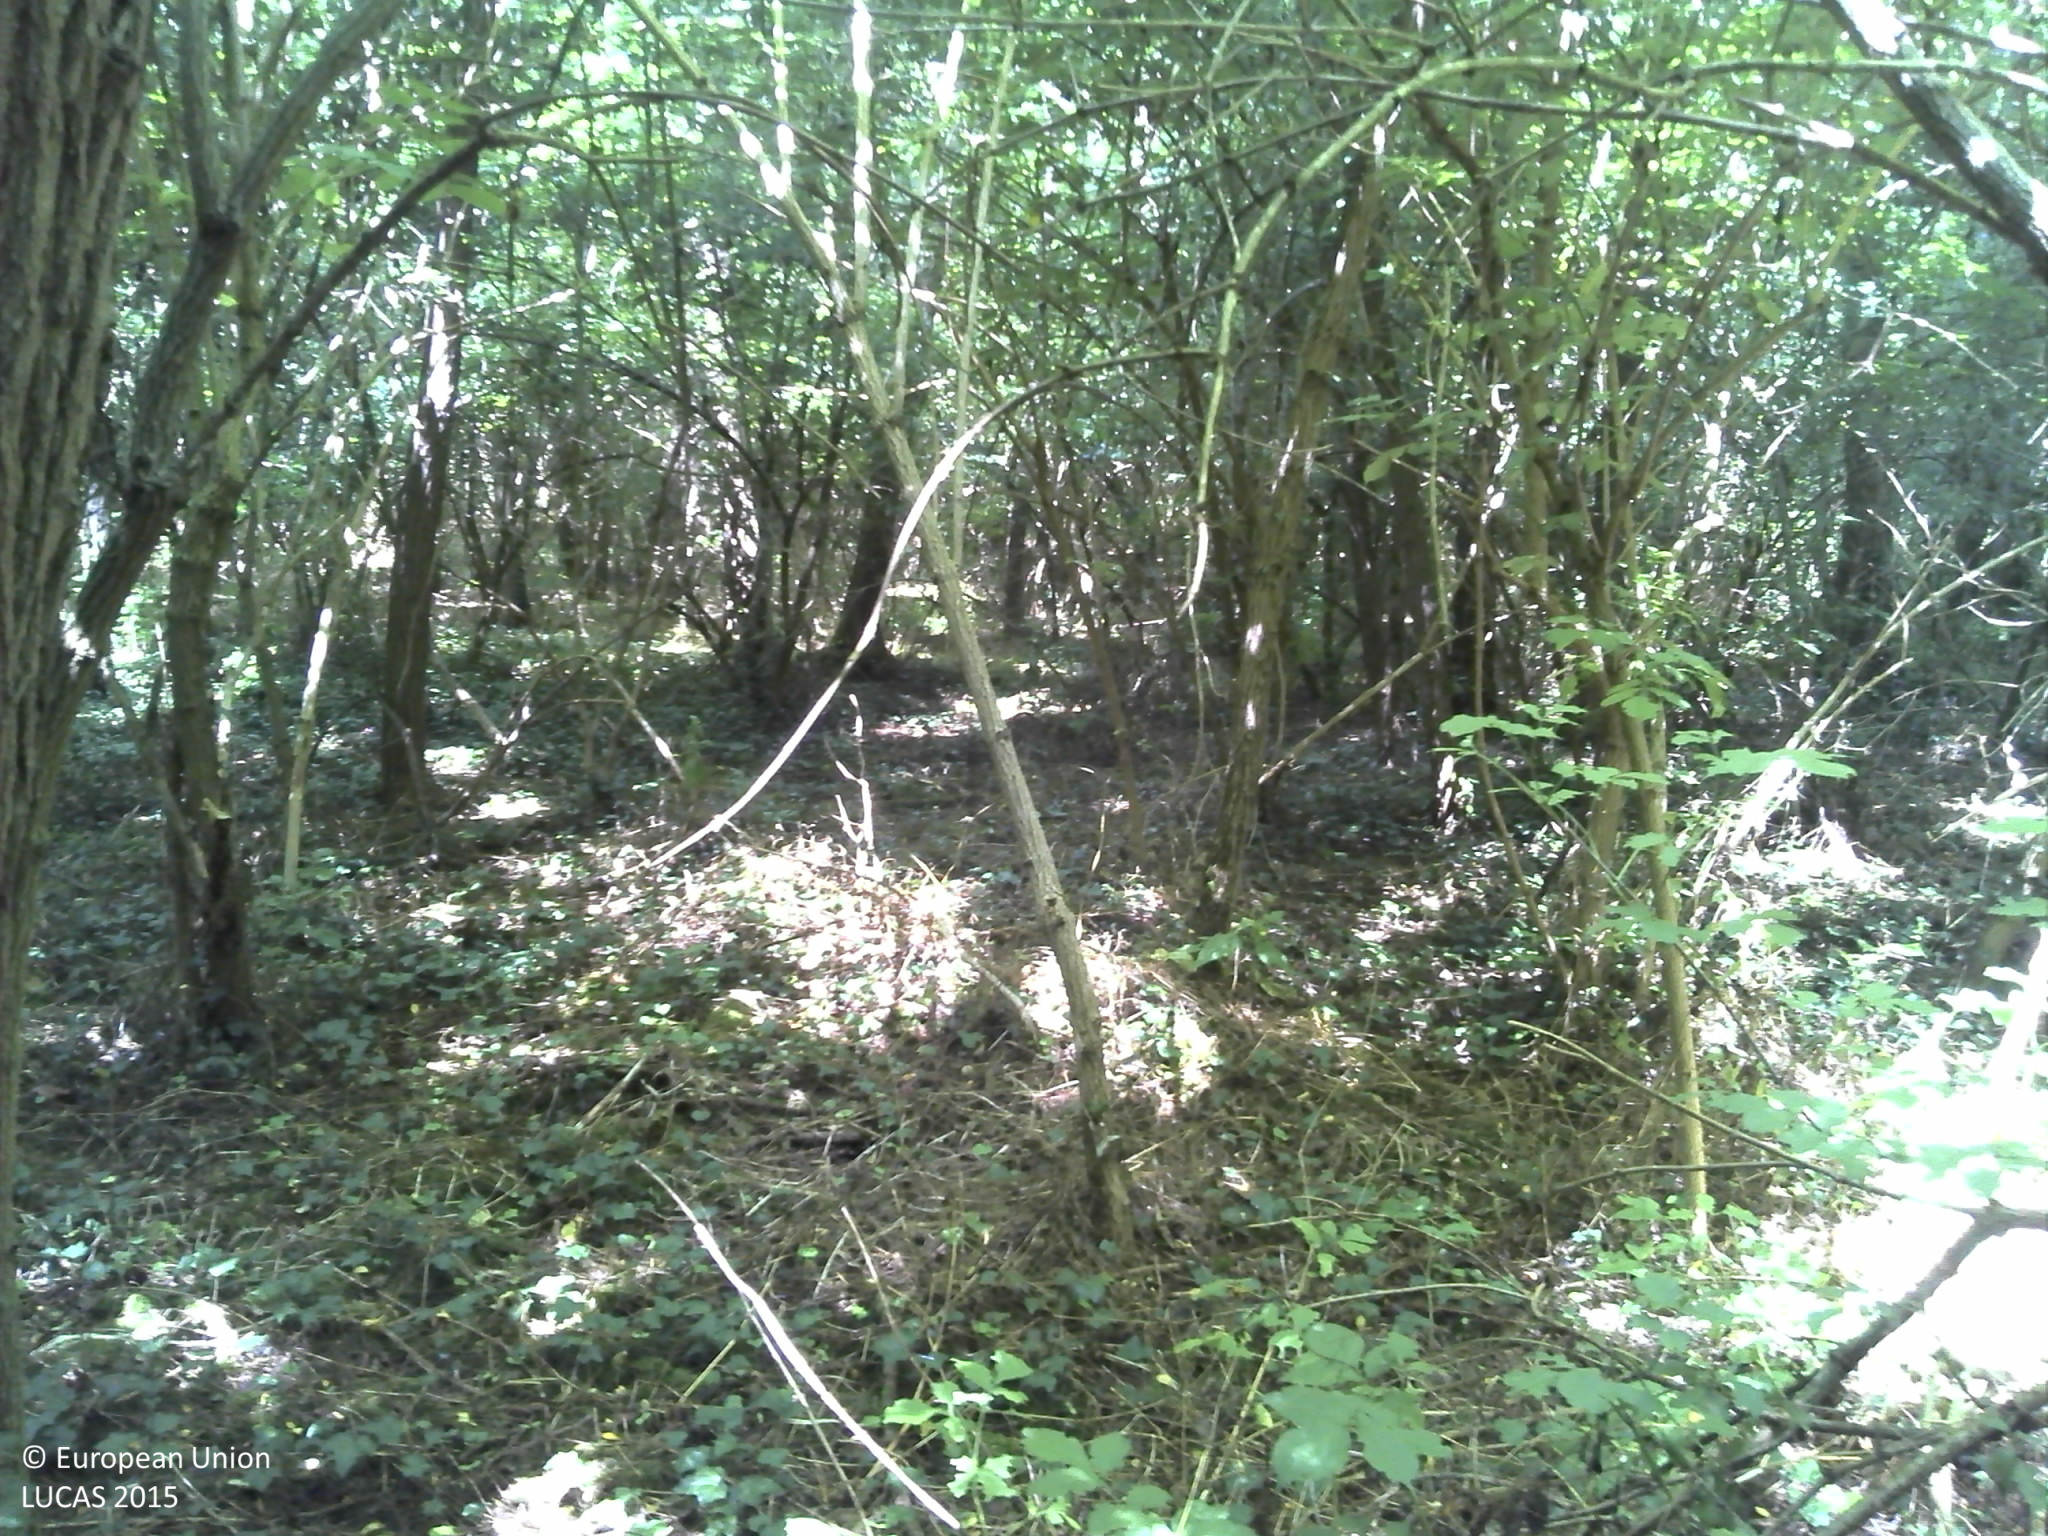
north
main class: Woodland
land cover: Broadleaved woodland
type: mesophytic deciduous forest
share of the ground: > 75 %
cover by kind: broadleaved forest trees 90 %, shrubs 5 %, herbaceous plants 5 %
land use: Forestry
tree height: > 5 m
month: June
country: HR
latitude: 45.7081
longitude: 18.6787
